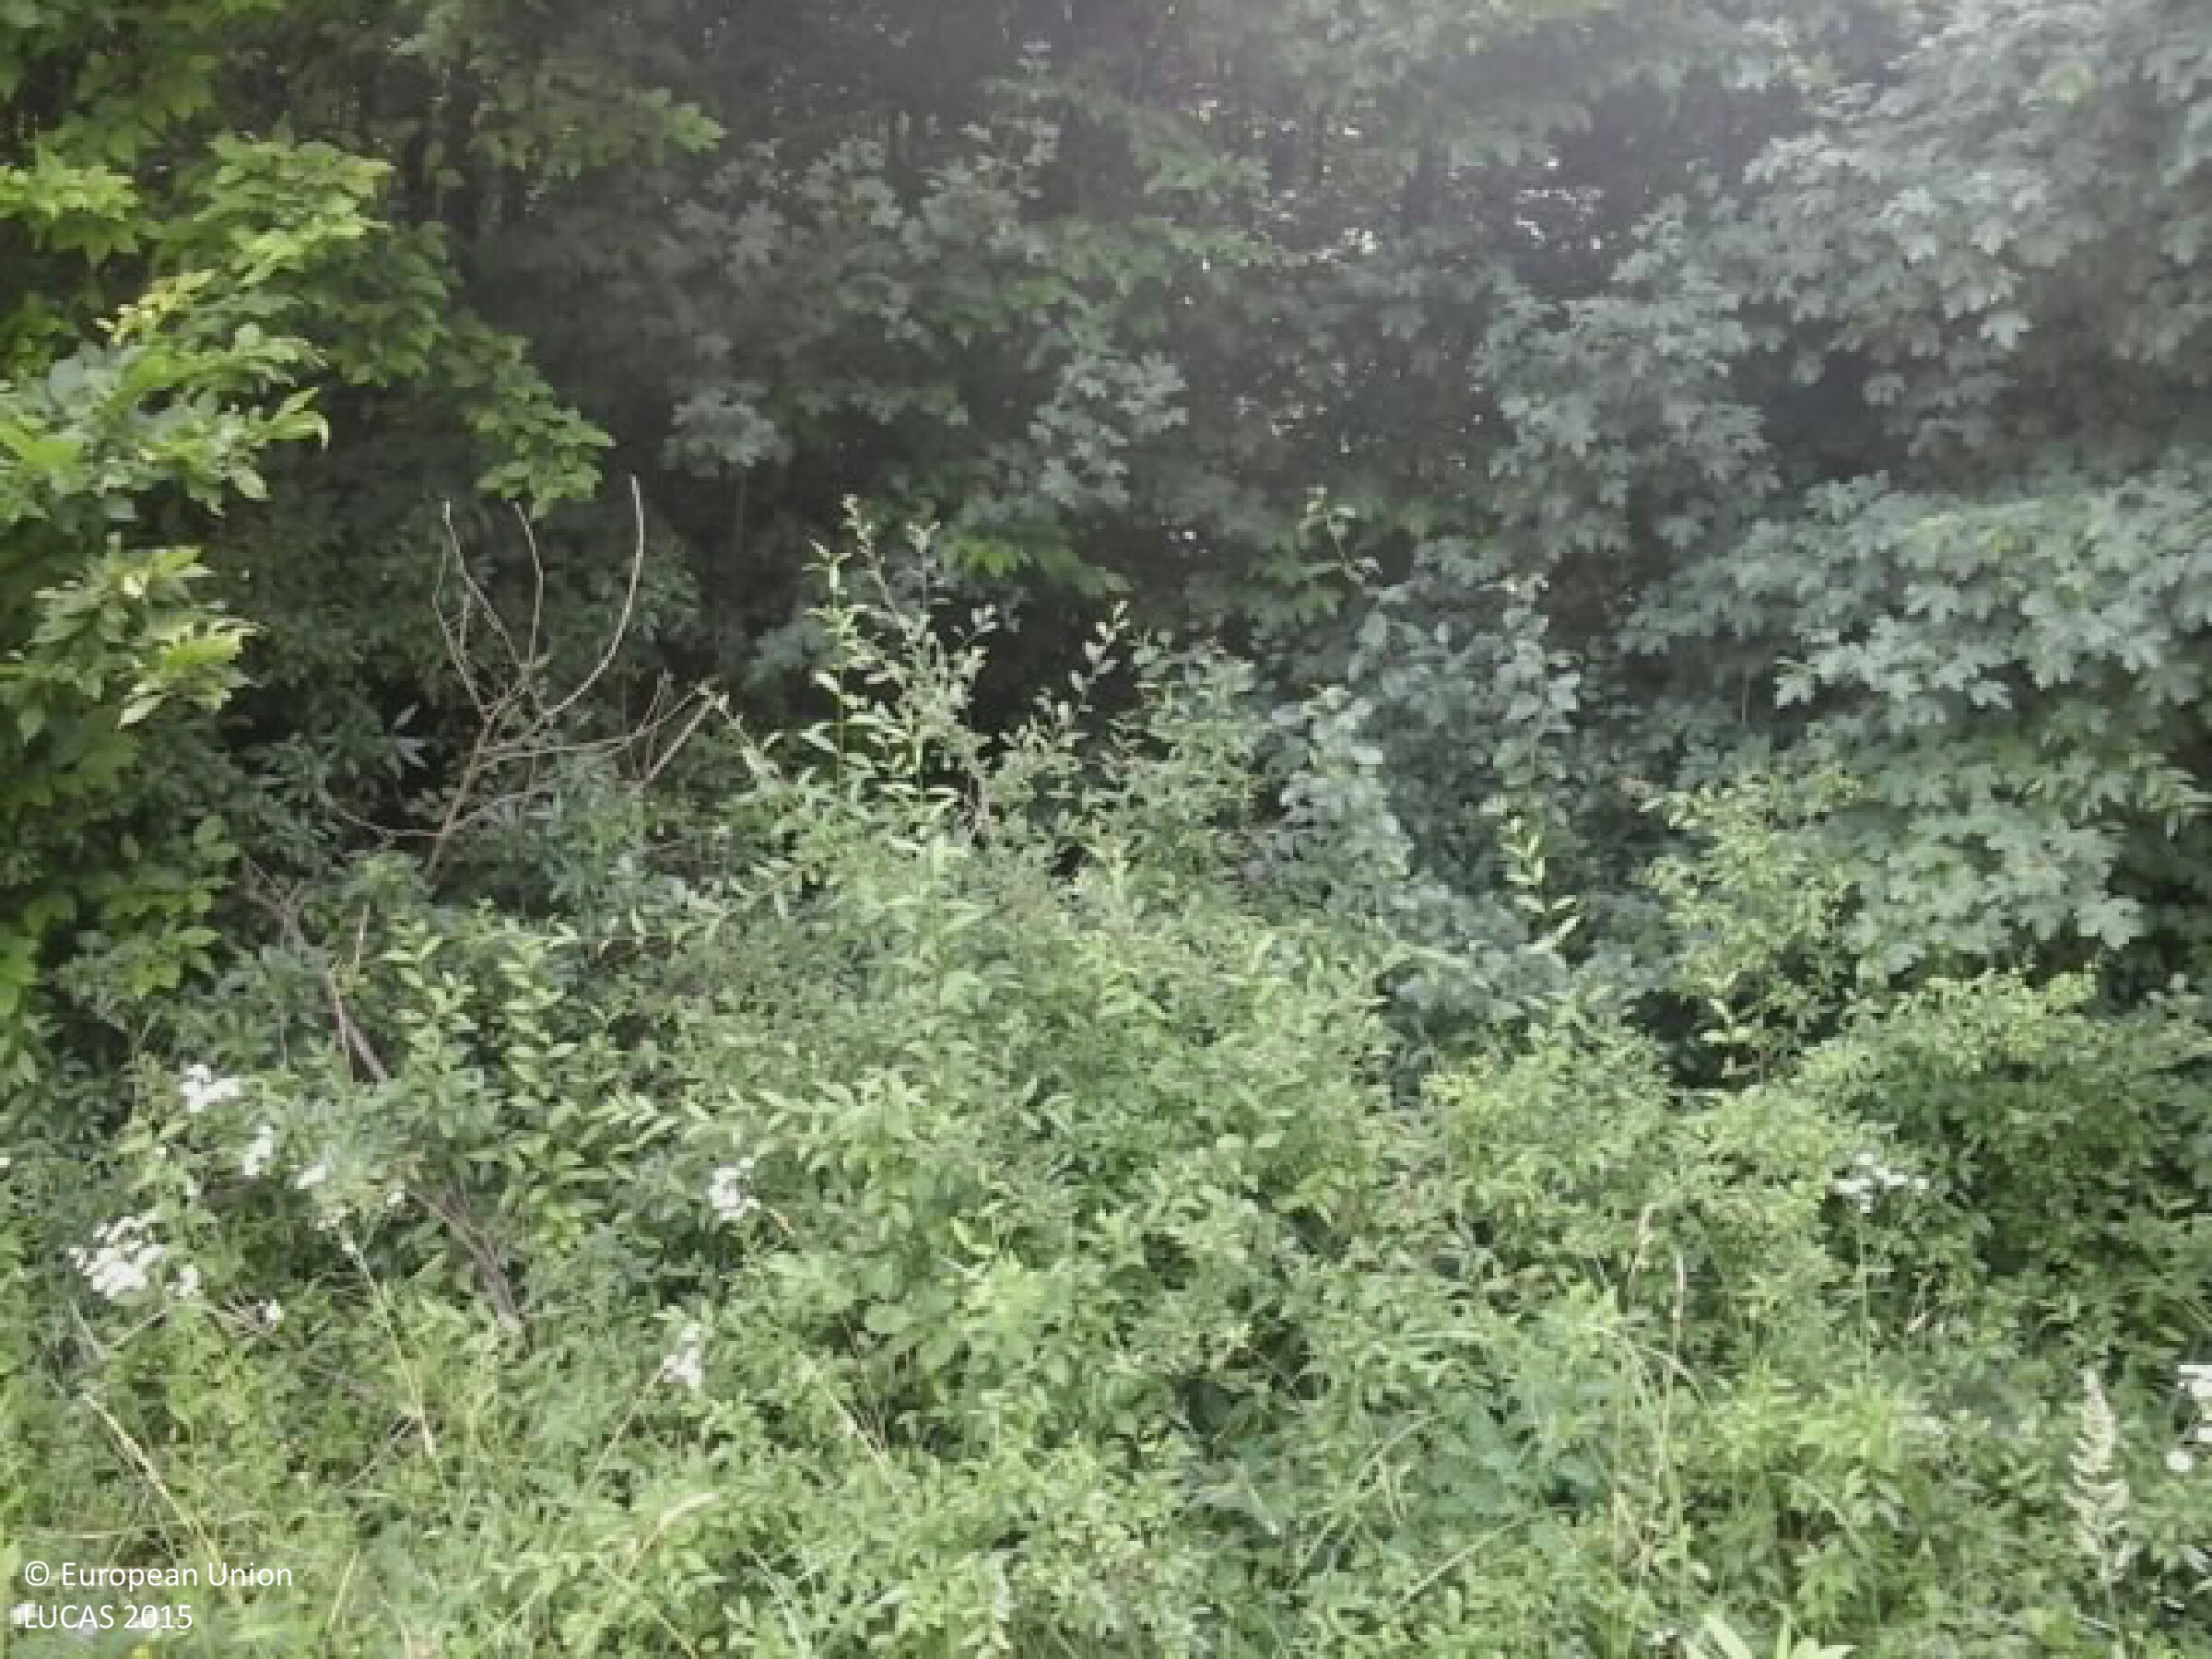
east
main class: Grassland
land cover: Spontaneously vegetated surfaces
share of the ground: > 75 %
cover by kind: herbaceous plants 100 %
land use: Semi-natural and natural areas not in use
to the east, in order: Spontaneously vegetated surfaces; Tracks; Broadleaved woodland
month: June
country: HU
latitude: 46.3308
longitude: 17.8912
